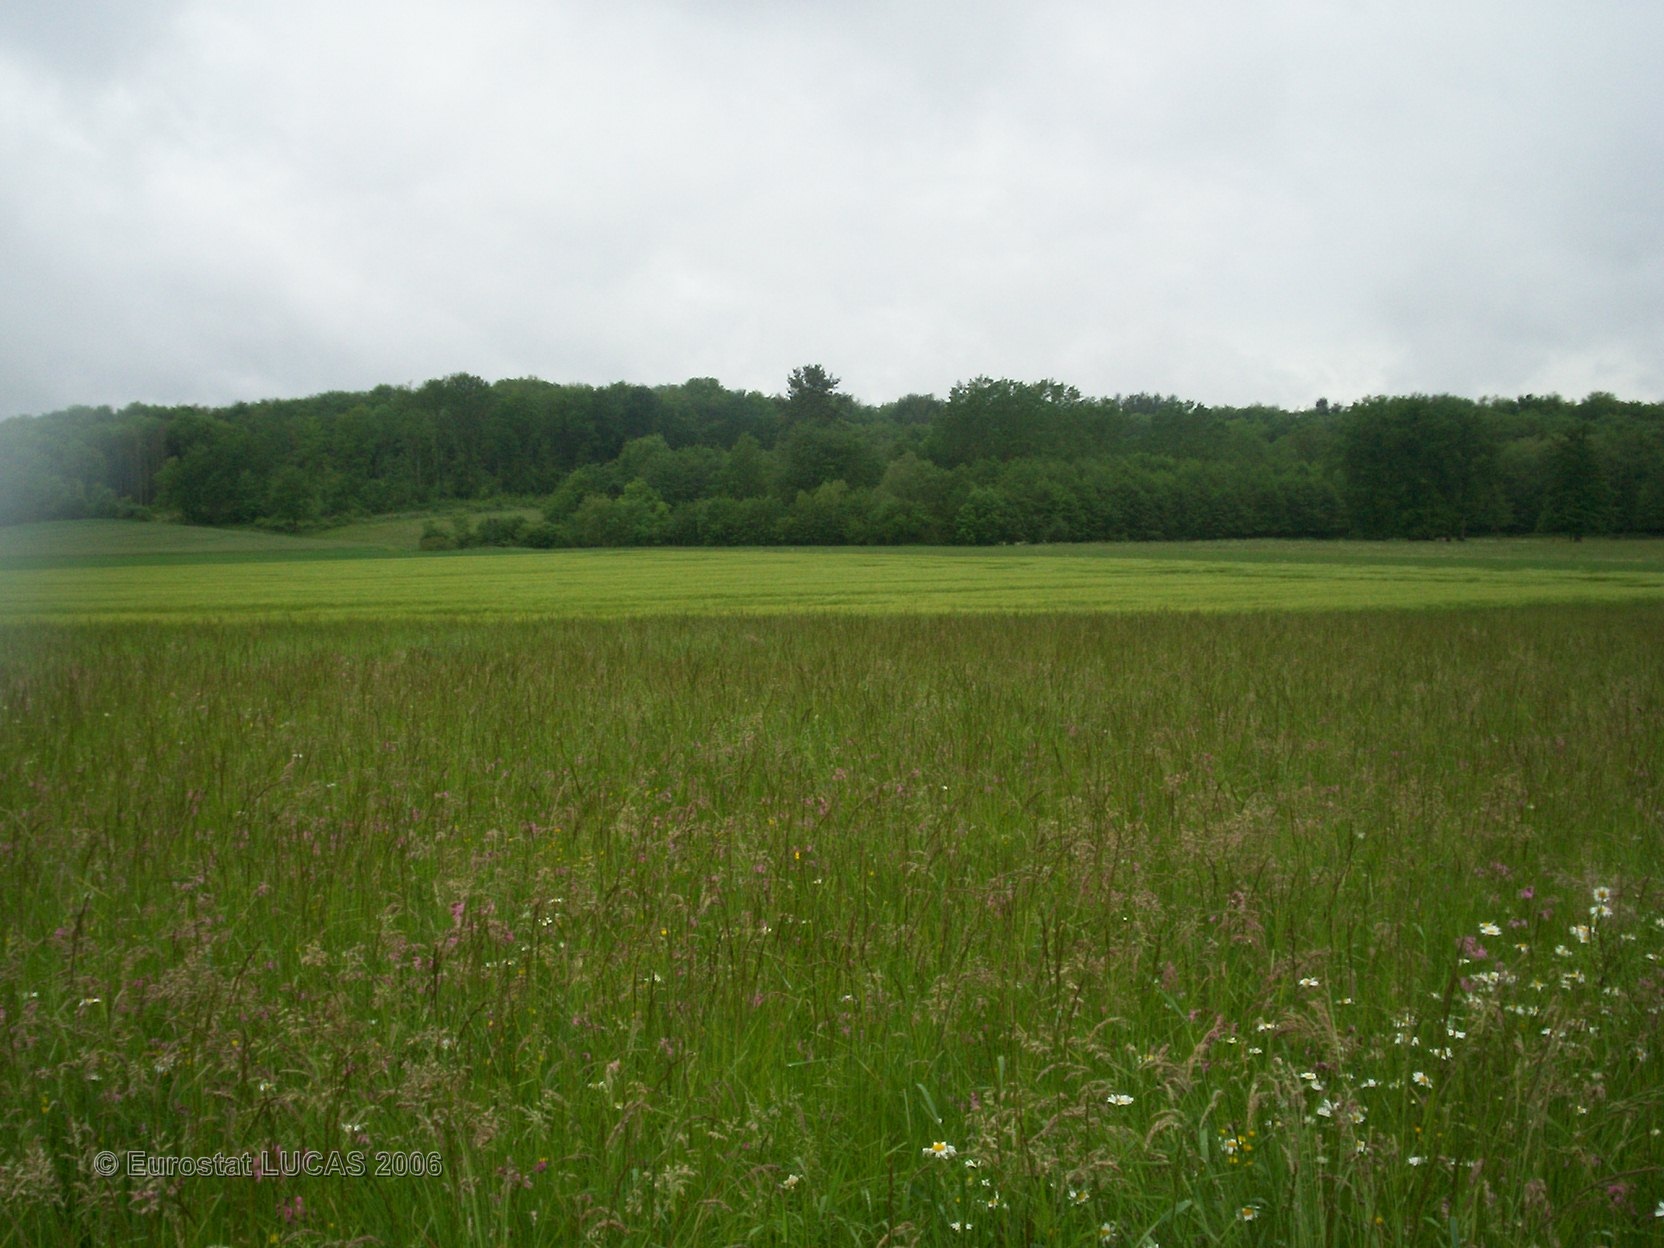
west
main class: Grassland
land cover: Grassland without tree/shrub cover
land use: Agriculture (excluding fallow land and kitchen gardens)
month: May
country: FR
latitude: 48.5378
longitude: 6.8178
